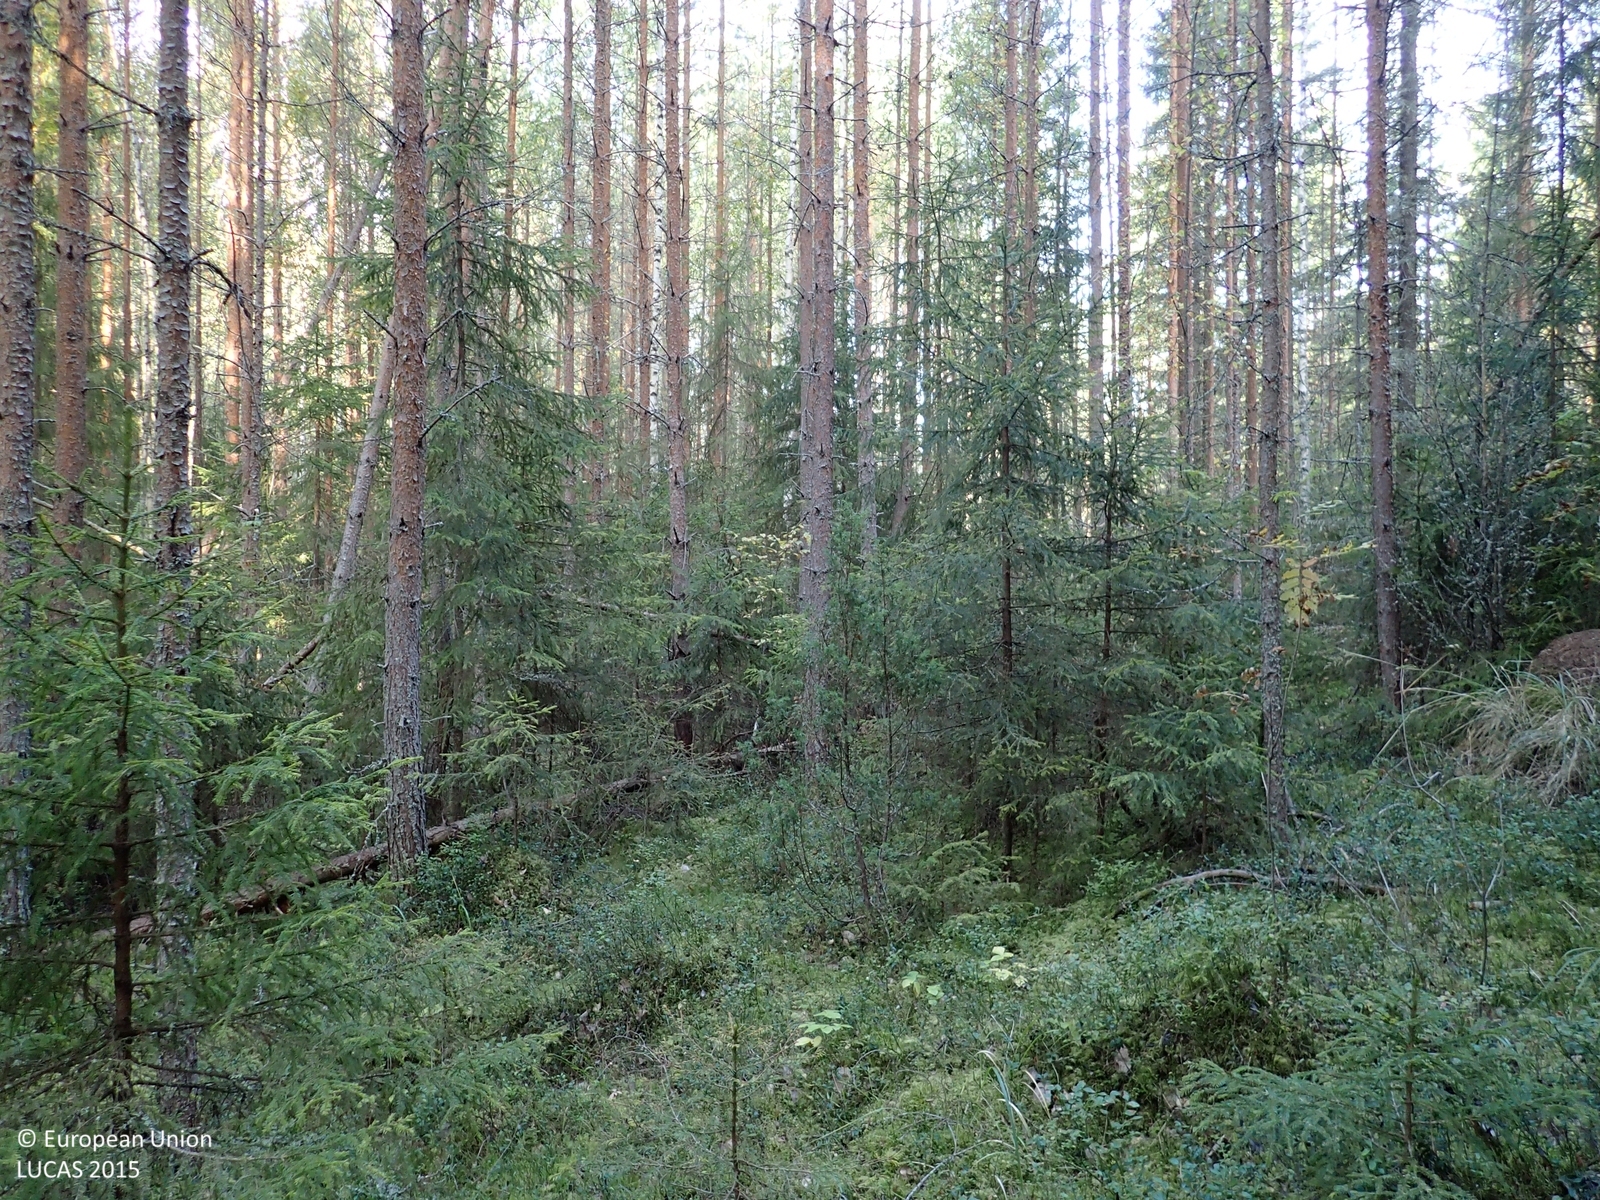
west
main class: Woodland
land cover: Spruce dominated coniferous woodland
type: boreal forest
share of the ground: > 75 %
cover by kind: coniferous forest trees 75 %, shrubs 15 %, broadleaved forest trees 5 %, lichens and mosses 5 %
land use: Forestry
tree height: > 5 m
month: September
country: FI
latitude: 63.0746
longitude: 25.6884
